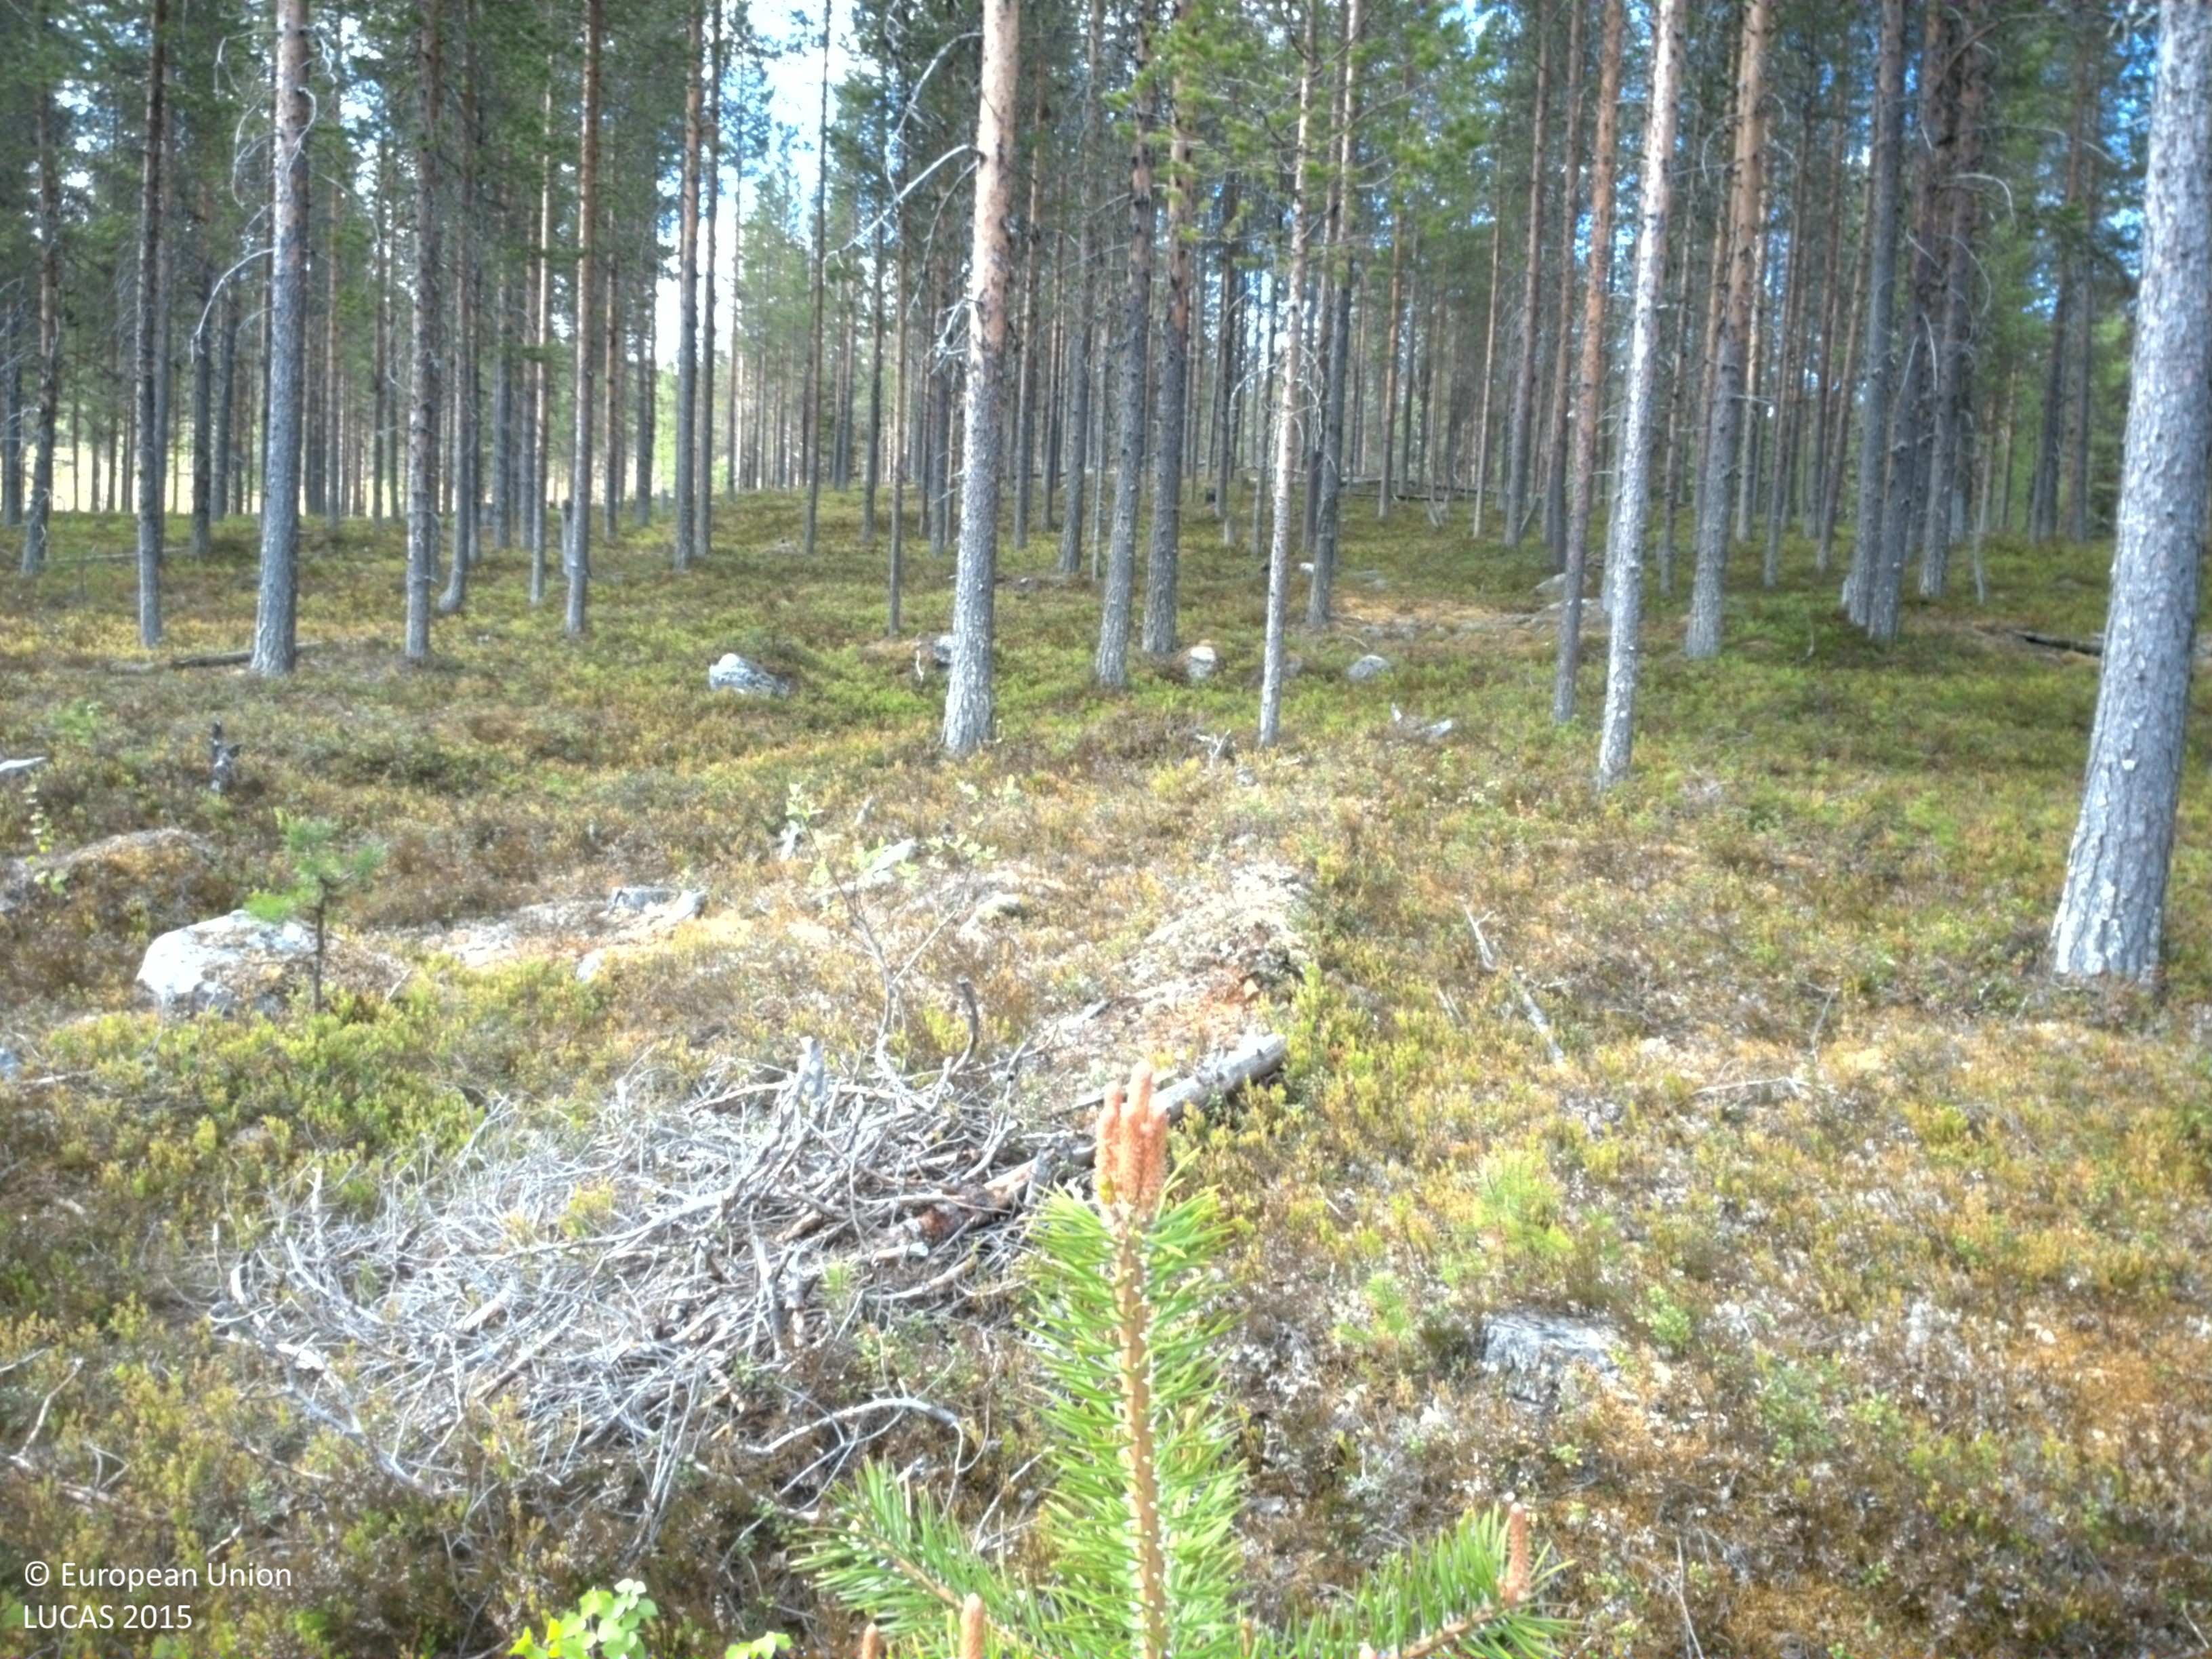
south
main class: Shrubland
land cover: Shrubland with sparse tree cover
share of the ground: > 75 %
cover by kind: shrubs 85 %, coniferous forest trees 5 %, lichens and mosses 5 %, consolidated bare surface 5 %
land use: Forestry
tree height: < 5 m
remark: Clear cut
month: June
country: SE
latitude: 65.9399
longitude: 19.7408
